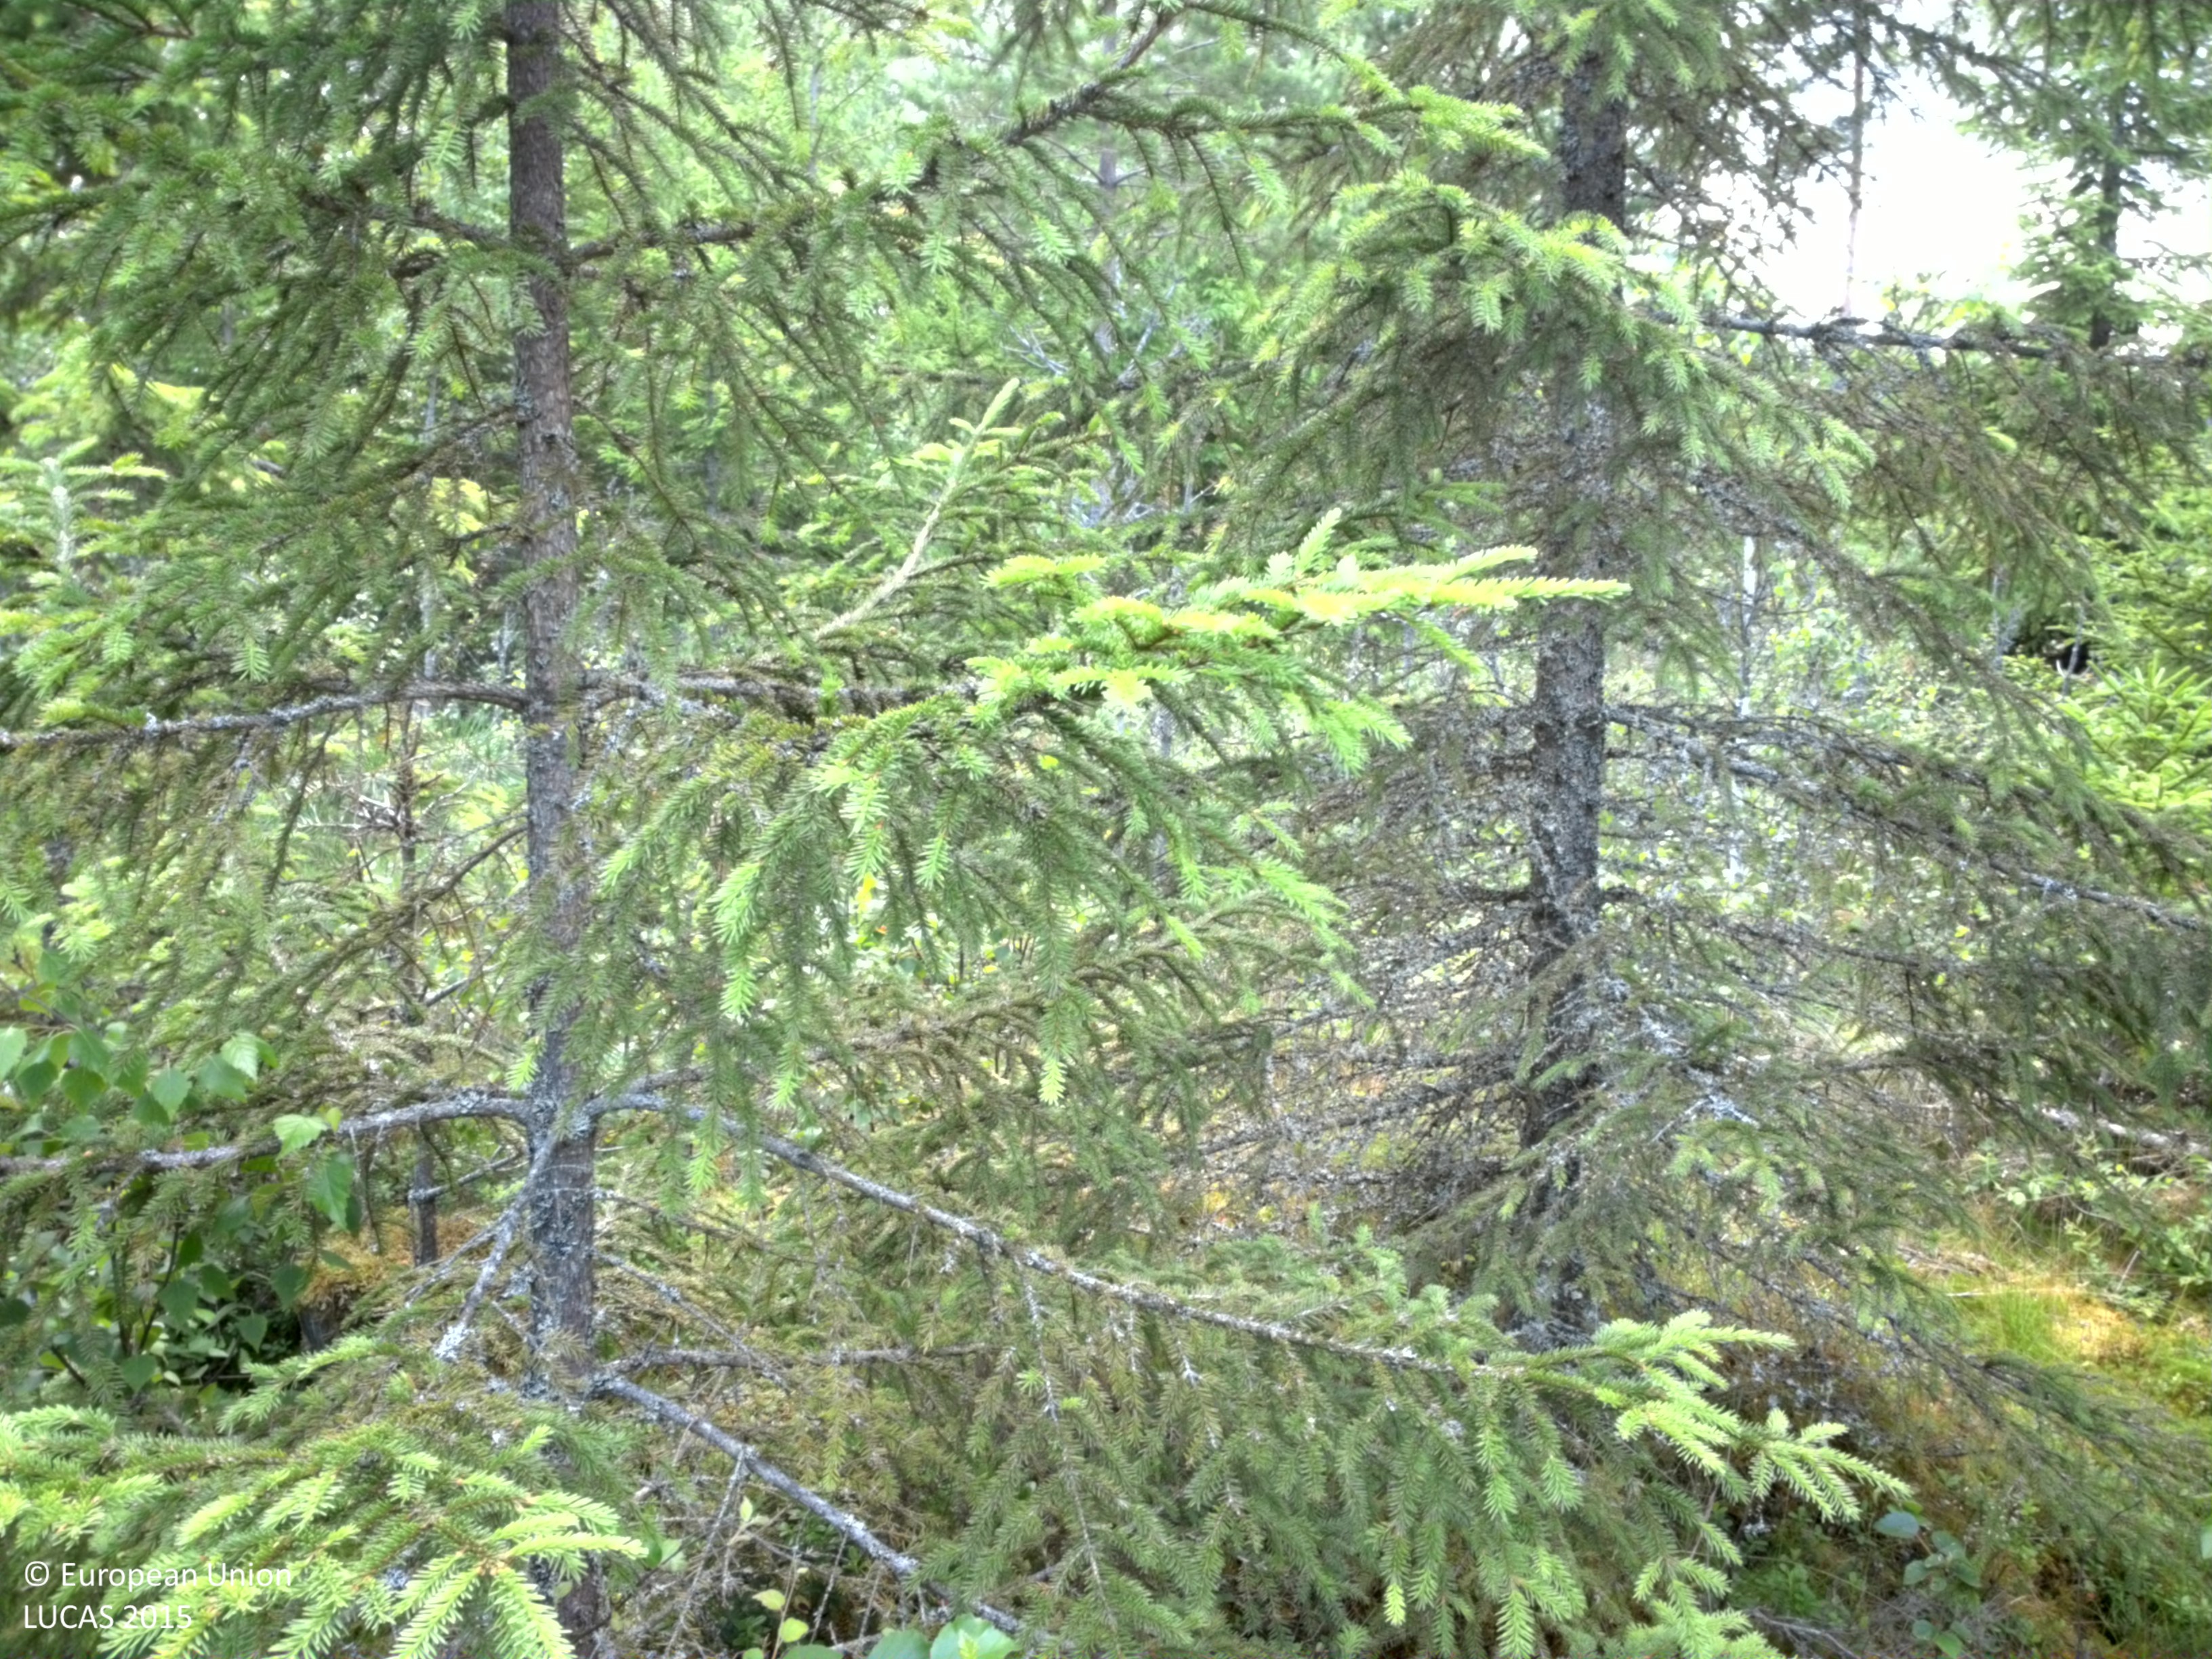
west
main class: Woodland
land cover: Spruce dominated mixed woodland
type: boreal forest
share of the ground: 50 - 75 %
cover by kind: coniferous forest trees 40 %, broadleaved forest trees 35 %, shrubs 20 %, lichens and mosses 5 %
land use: Forestry
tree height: < 5 m
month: July
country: SE
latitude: 58.5817
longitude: 14.3447
